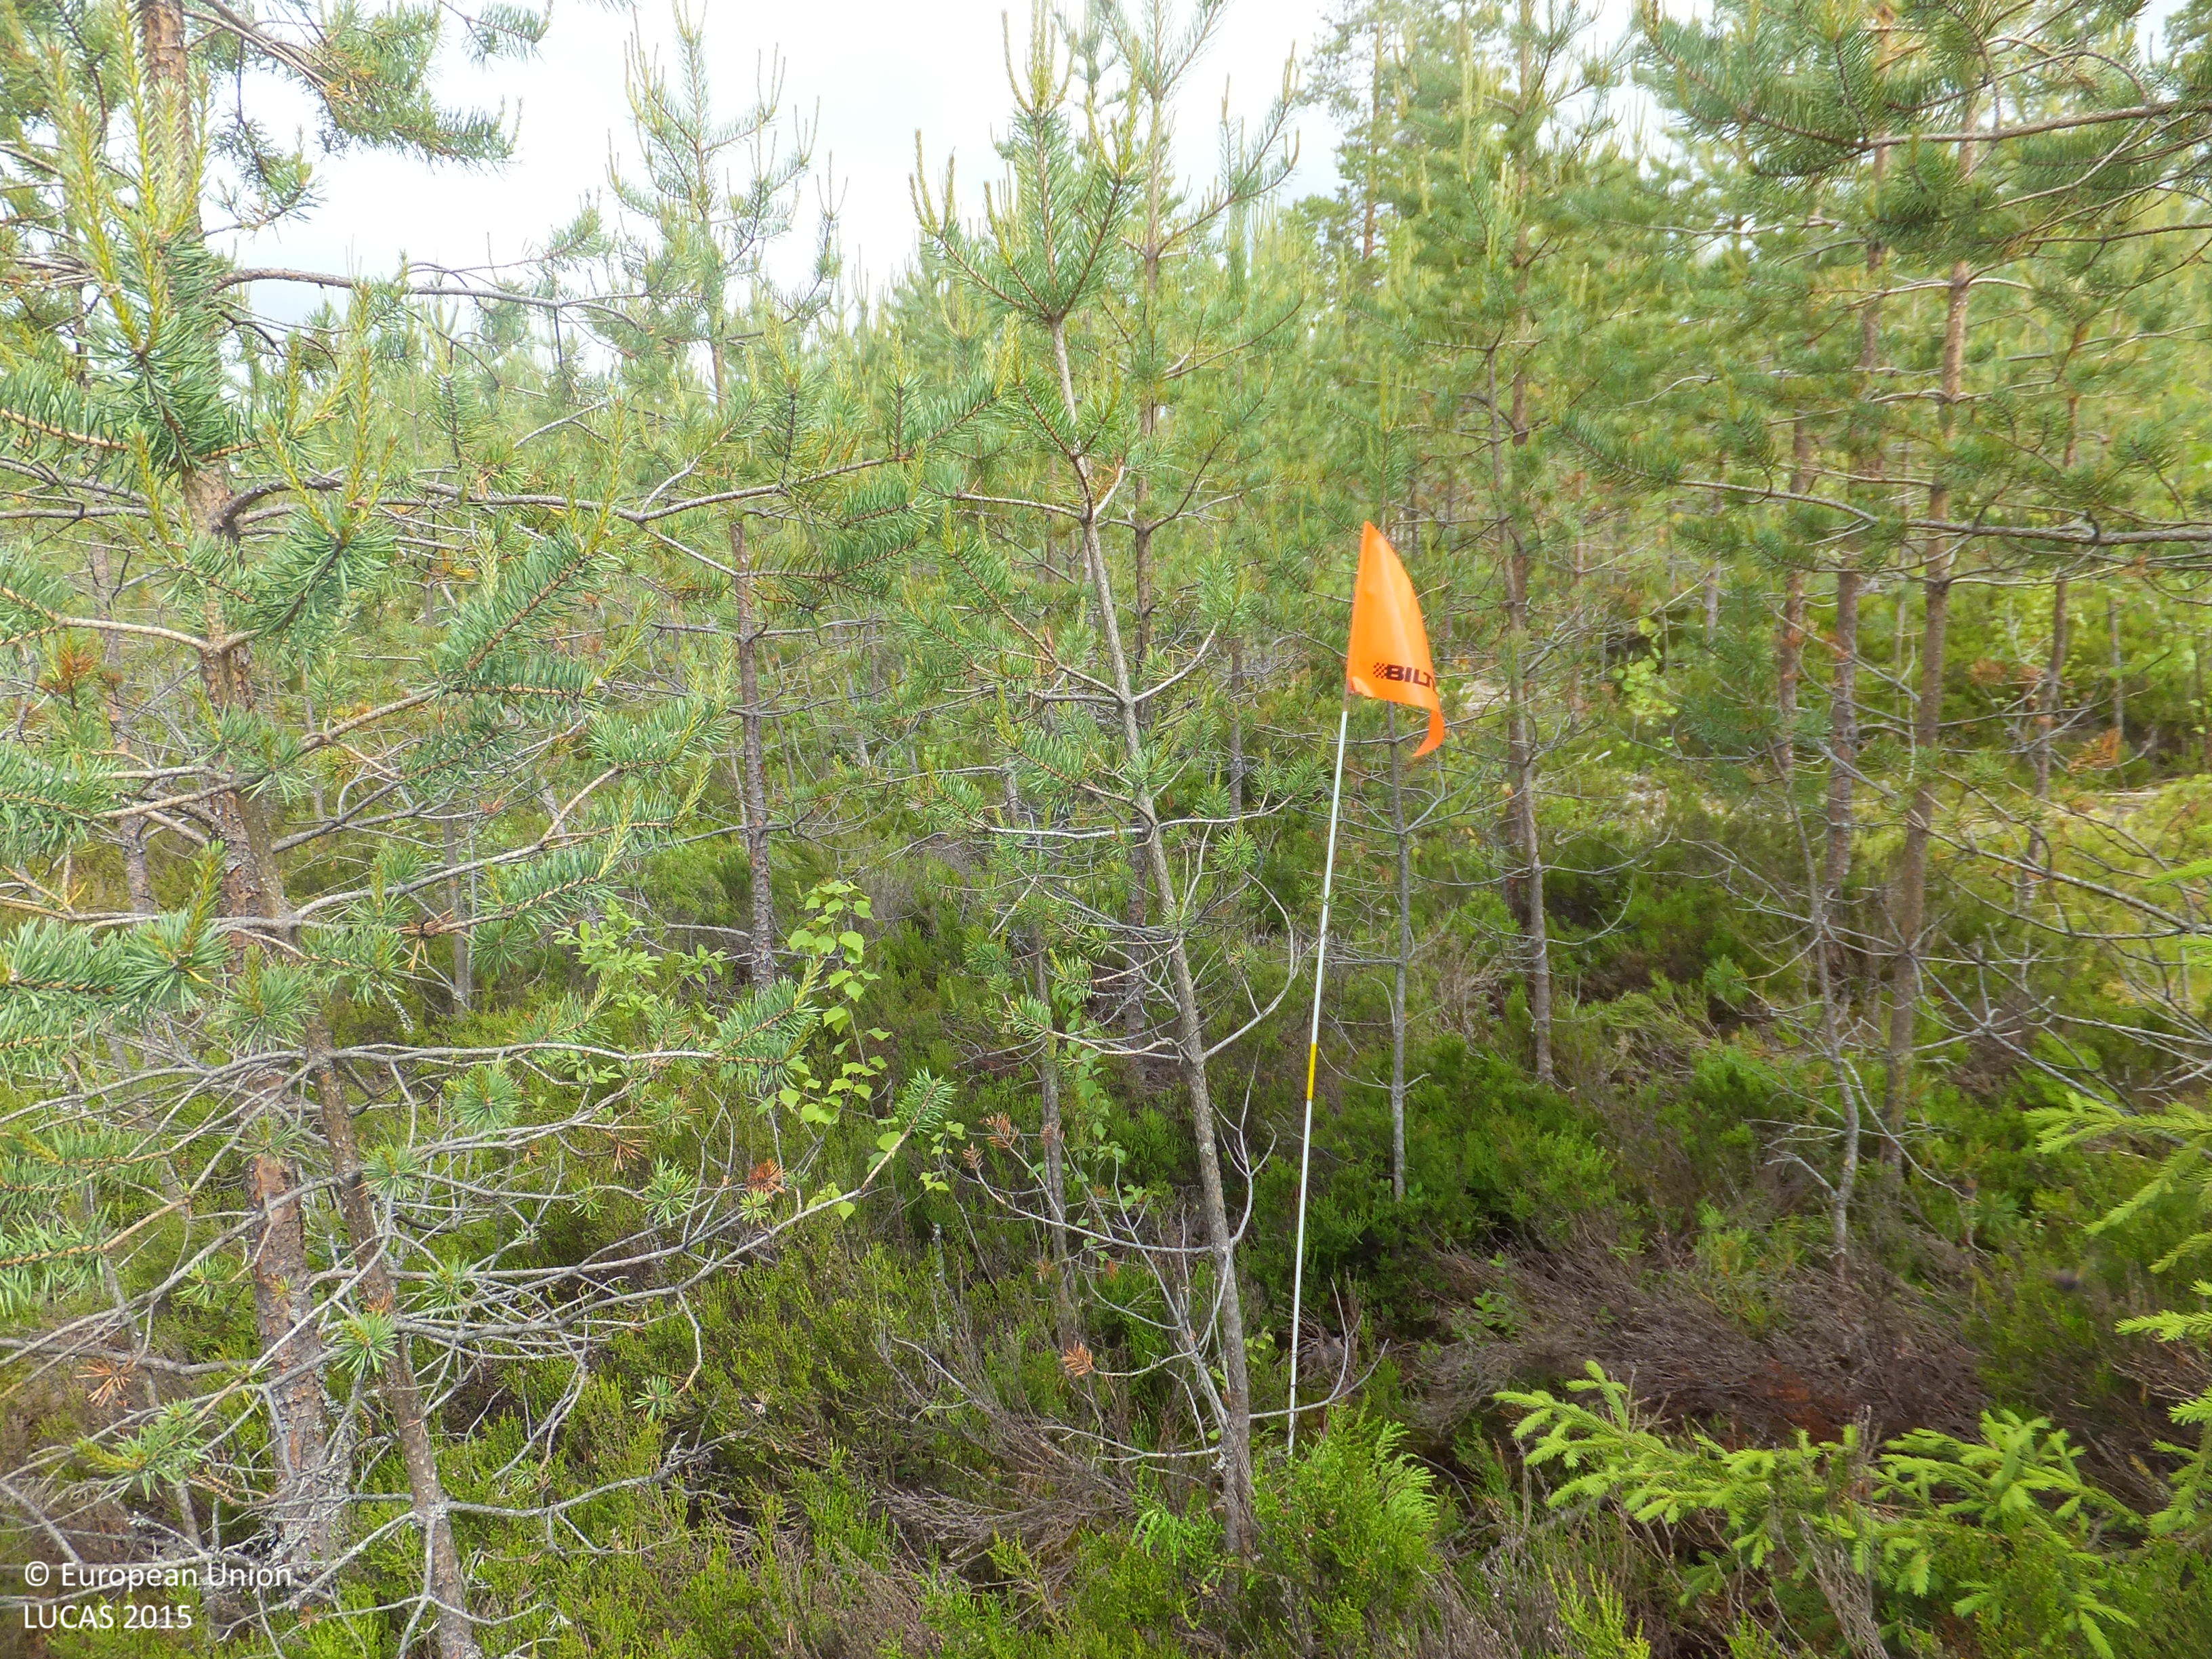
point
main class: Woodland
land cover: Pine dominated coniferous woodland
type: mire and swamp forests
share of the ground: > 75 %
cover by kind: coniferous forest trees 80 %, shrubs 10 %, broadleaved forest trees 5 %, lichens and mosses 5 %
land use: Forestry
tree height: < 5 m
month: June
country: FI
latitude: 63.2836
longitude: 23.9277
